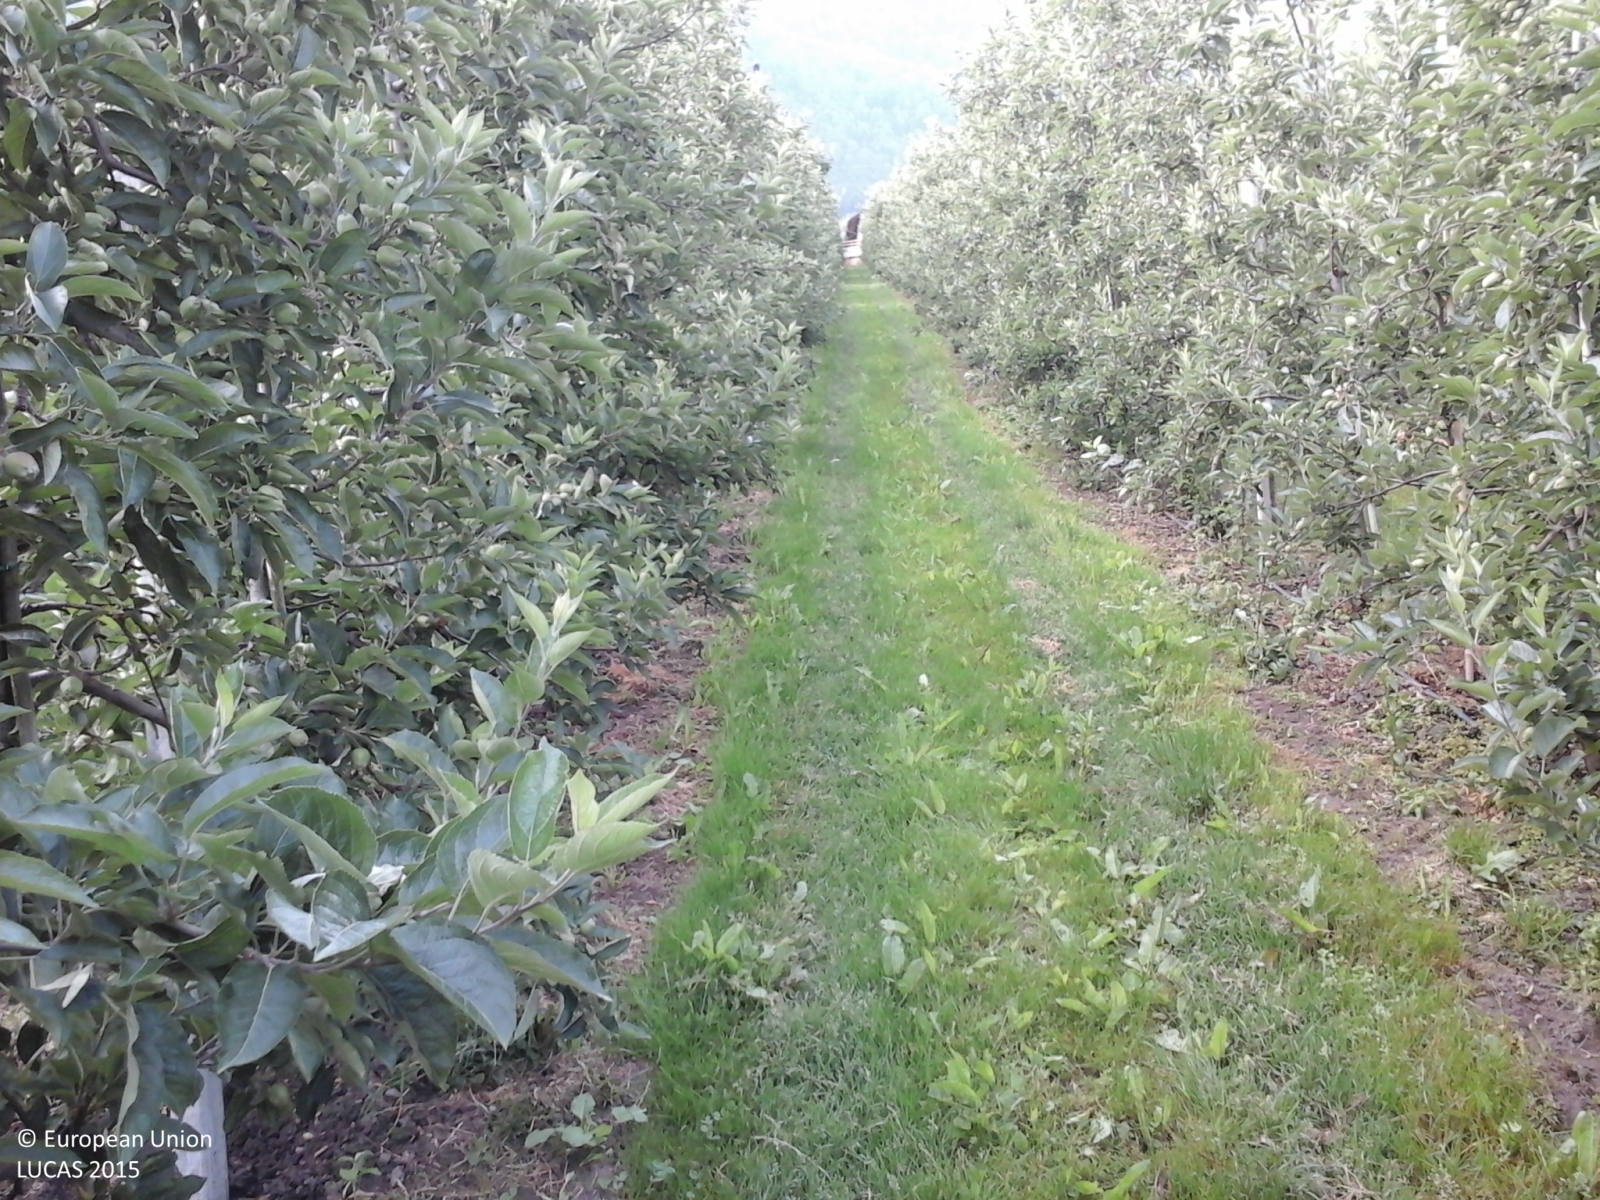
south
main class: Cropland
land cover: Apple fruit
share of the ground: > 75 %
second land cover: Grassland without tree/shrub cover
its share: > 75 %
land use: Agriculture (excluding fallow land and kitchen gardens)
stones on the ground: < 10 %
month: June
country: IT
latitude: 46.6349
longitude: 10.9785
